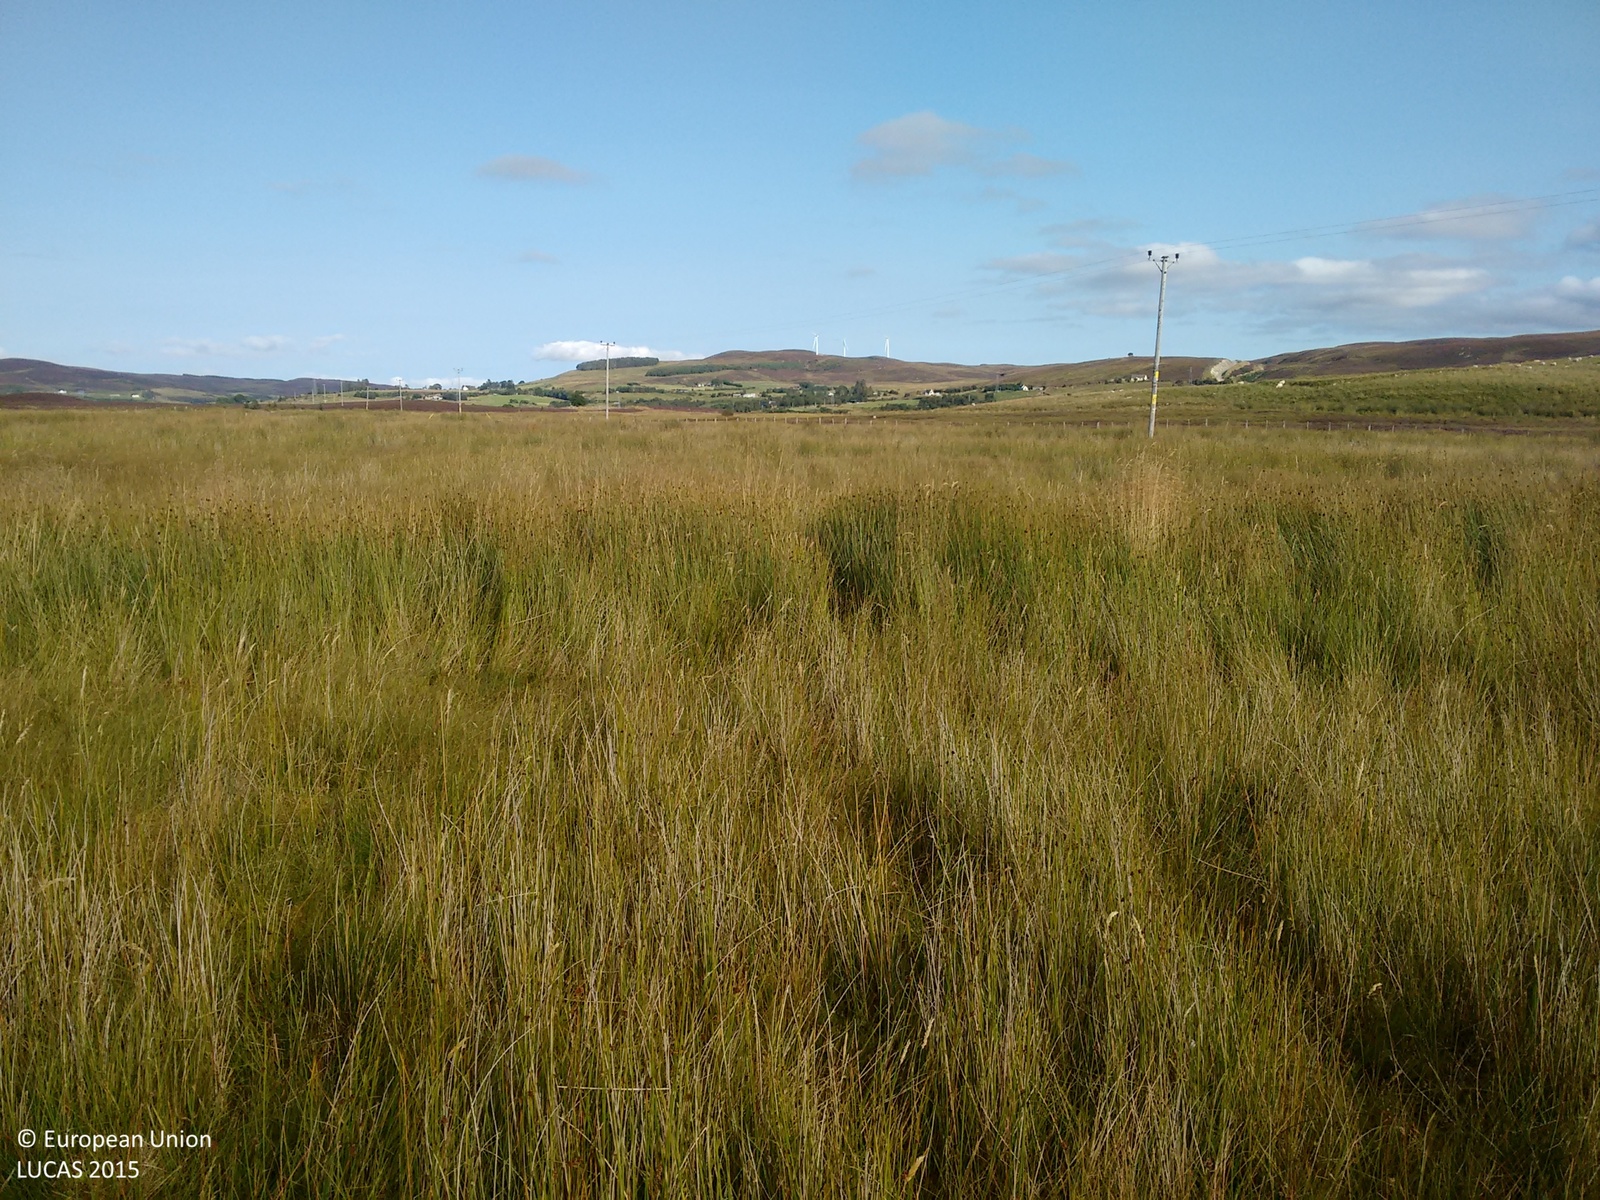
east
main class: Grassland
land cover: Grassland without tree/shrub cover
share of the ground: > 75 %
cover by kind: herbaceous plants 70 %, lichens and mosses 30 %
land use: Agriculture (excluding fallow land and kitchen gardens)
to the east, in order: Grassland without tree/shrub cover; Electric lines; Grassland without tree/shrub cover; Fences; Shrubland without tree cover; Peatbogs; Grassland without tree/shrub cover
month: September
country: GB
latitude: 58.0041
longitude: -4.4186
